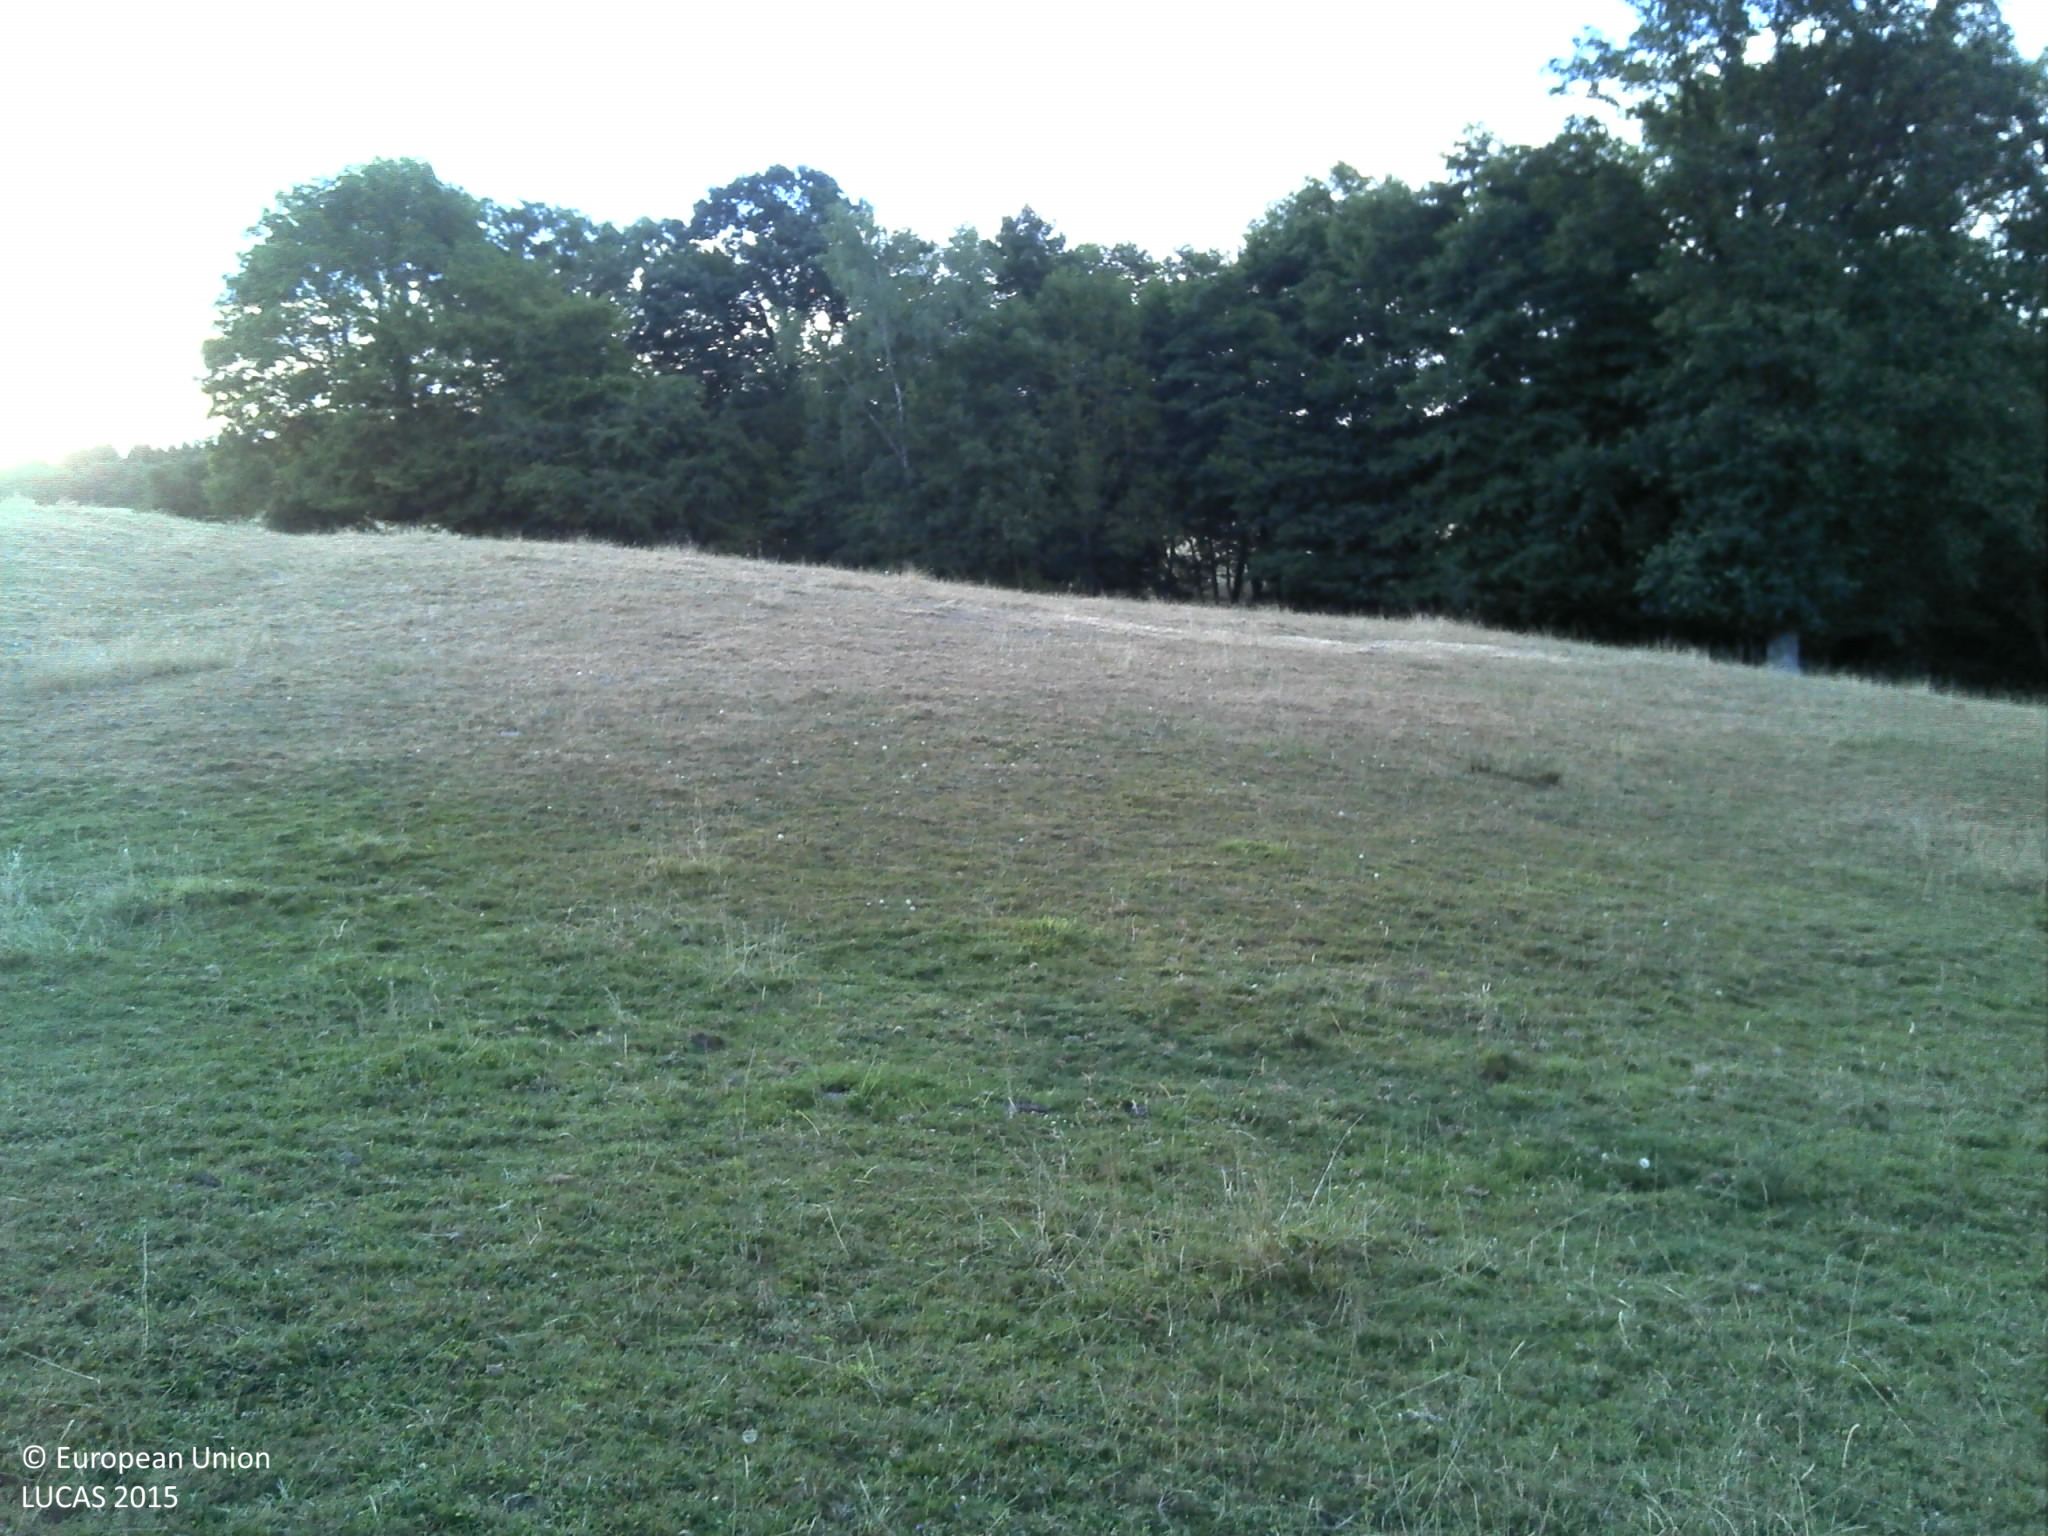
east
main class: Grassland
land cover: Grassland with sparse tree/shrub cover
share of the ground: > 75 %
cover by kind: herbaceous plants 95 %, broadleaved forest trees 5 %
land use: Agriculture (excluding fallow land and kitchen gardens)
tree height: > 5 m
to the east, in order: Grassland with sparse tree/shrub cover; Broadleaved woodland; Fences; Grass margins; Fences; Broadleaved woodland; Grassland without tree/shrub cover; Shrubland with sparse tree cover; Grassland without tree/shrub cover
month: July
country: FR
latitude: 48.3017
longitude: 6.1852
